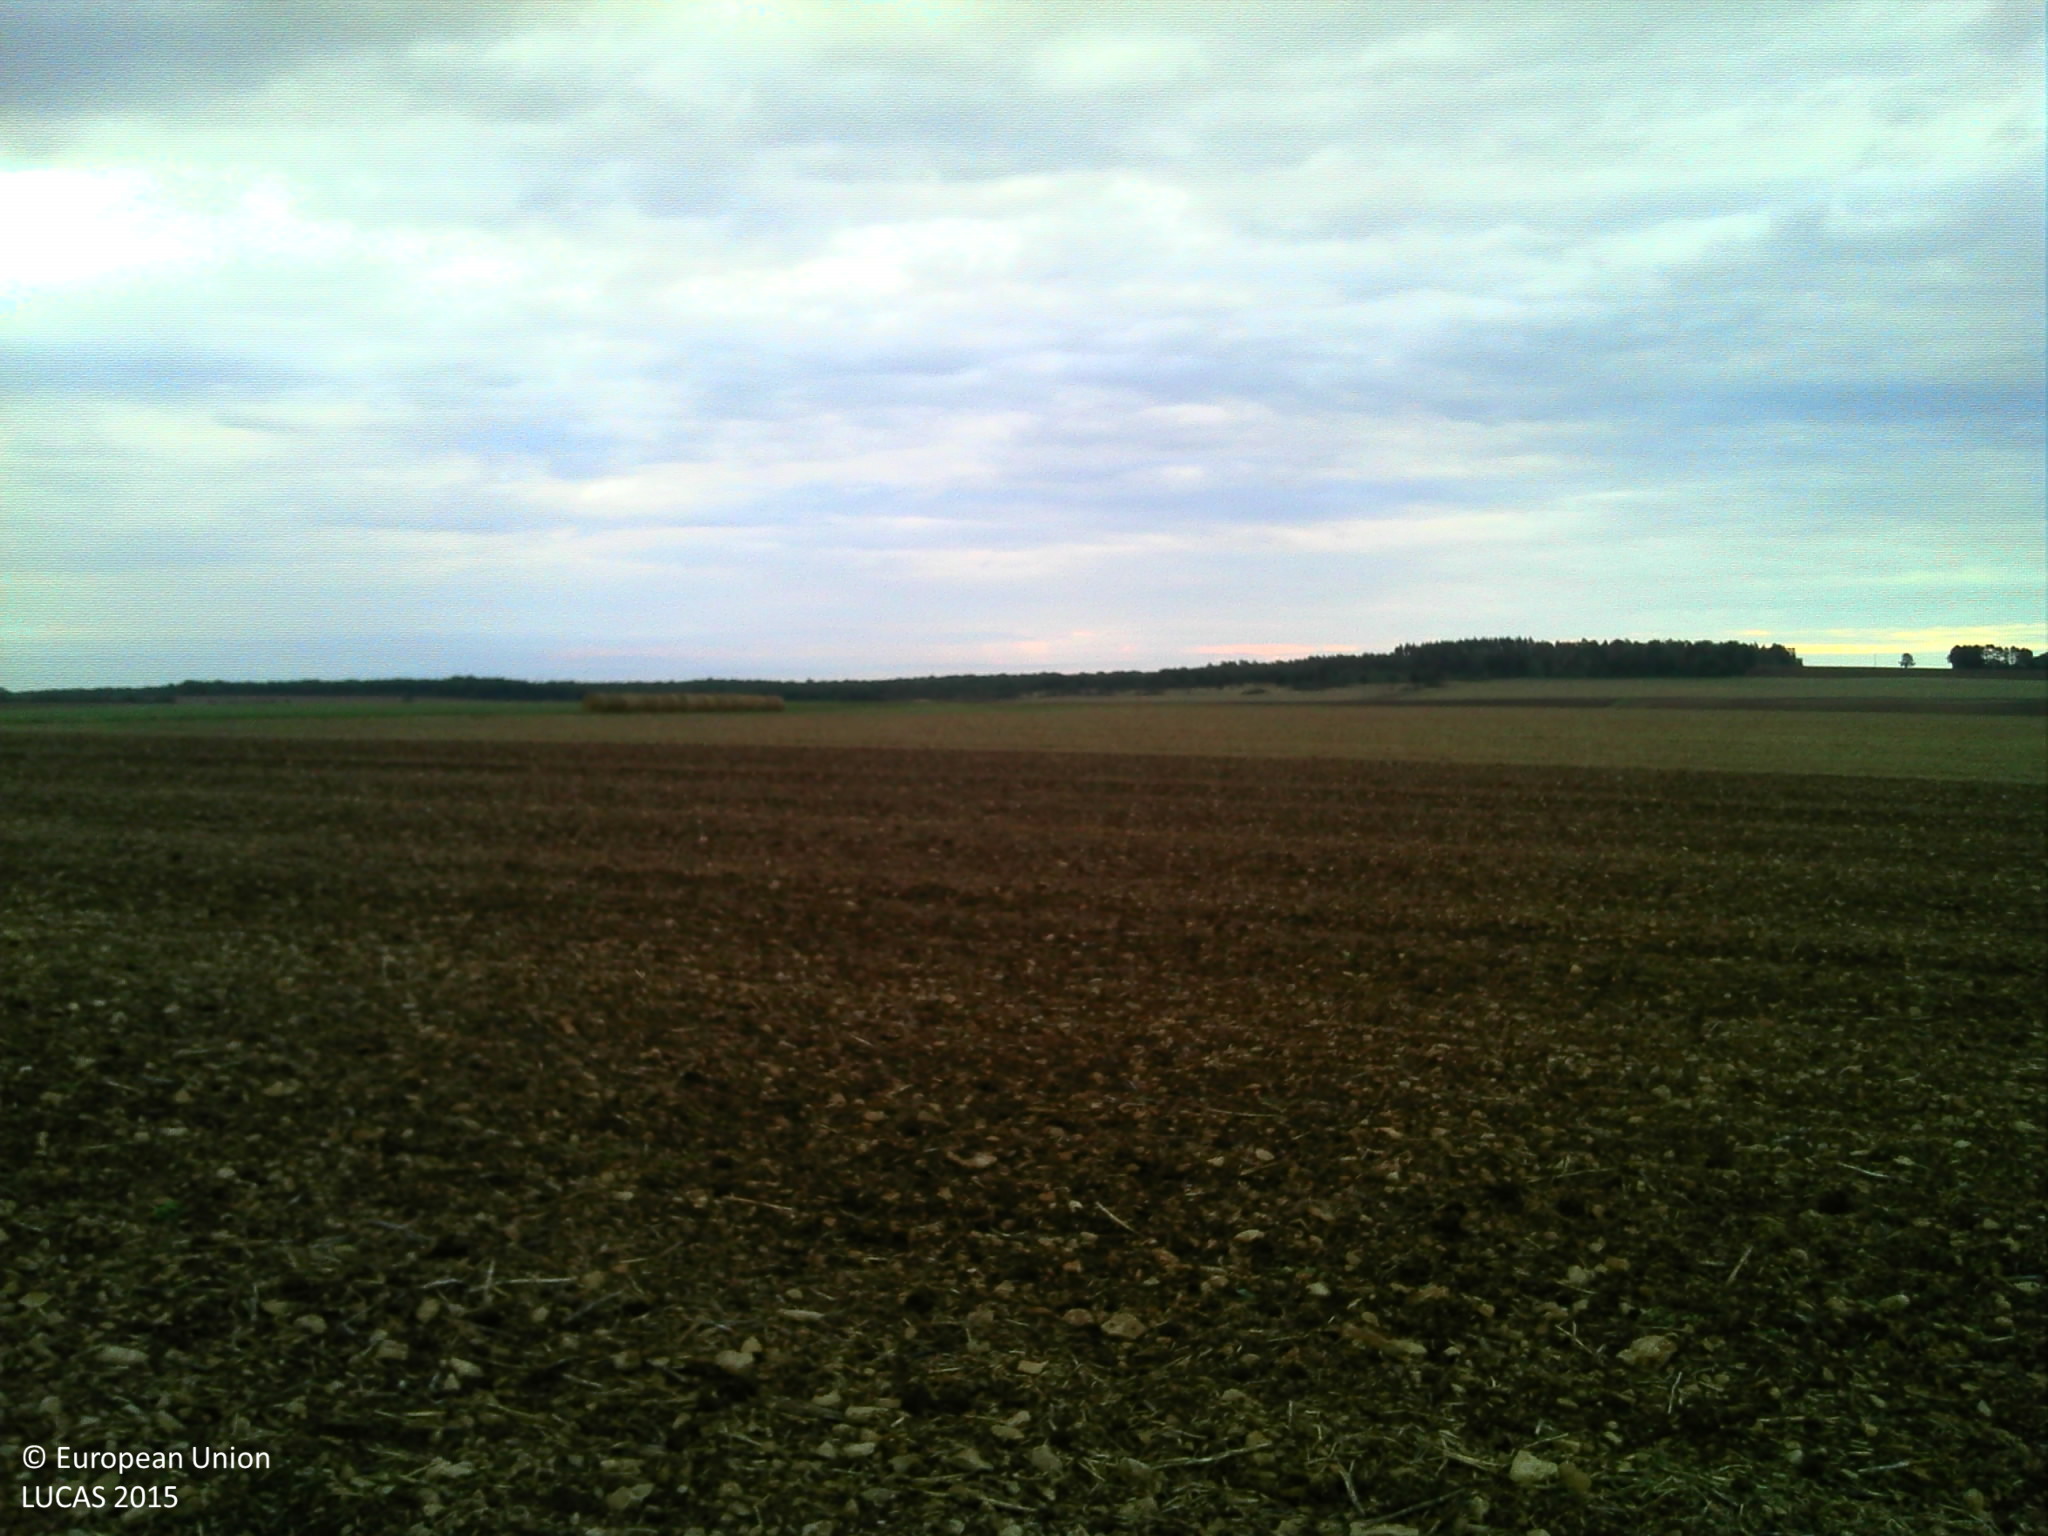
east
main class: Cropland
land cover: Rape and turnip rape
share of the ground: < 10 %
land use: Agriculture (excluding fallow land and kitchen gardens)
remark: Harvested field
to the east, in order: Rape and turnip rape; Other bare soil; Spontaneously vegetated surfaces; Grass margins; Tracks; Grass margins; Tracks; Grass margins; Rape and turnip rape
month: August
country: FR
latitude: 47.4344
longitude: 4.8157
